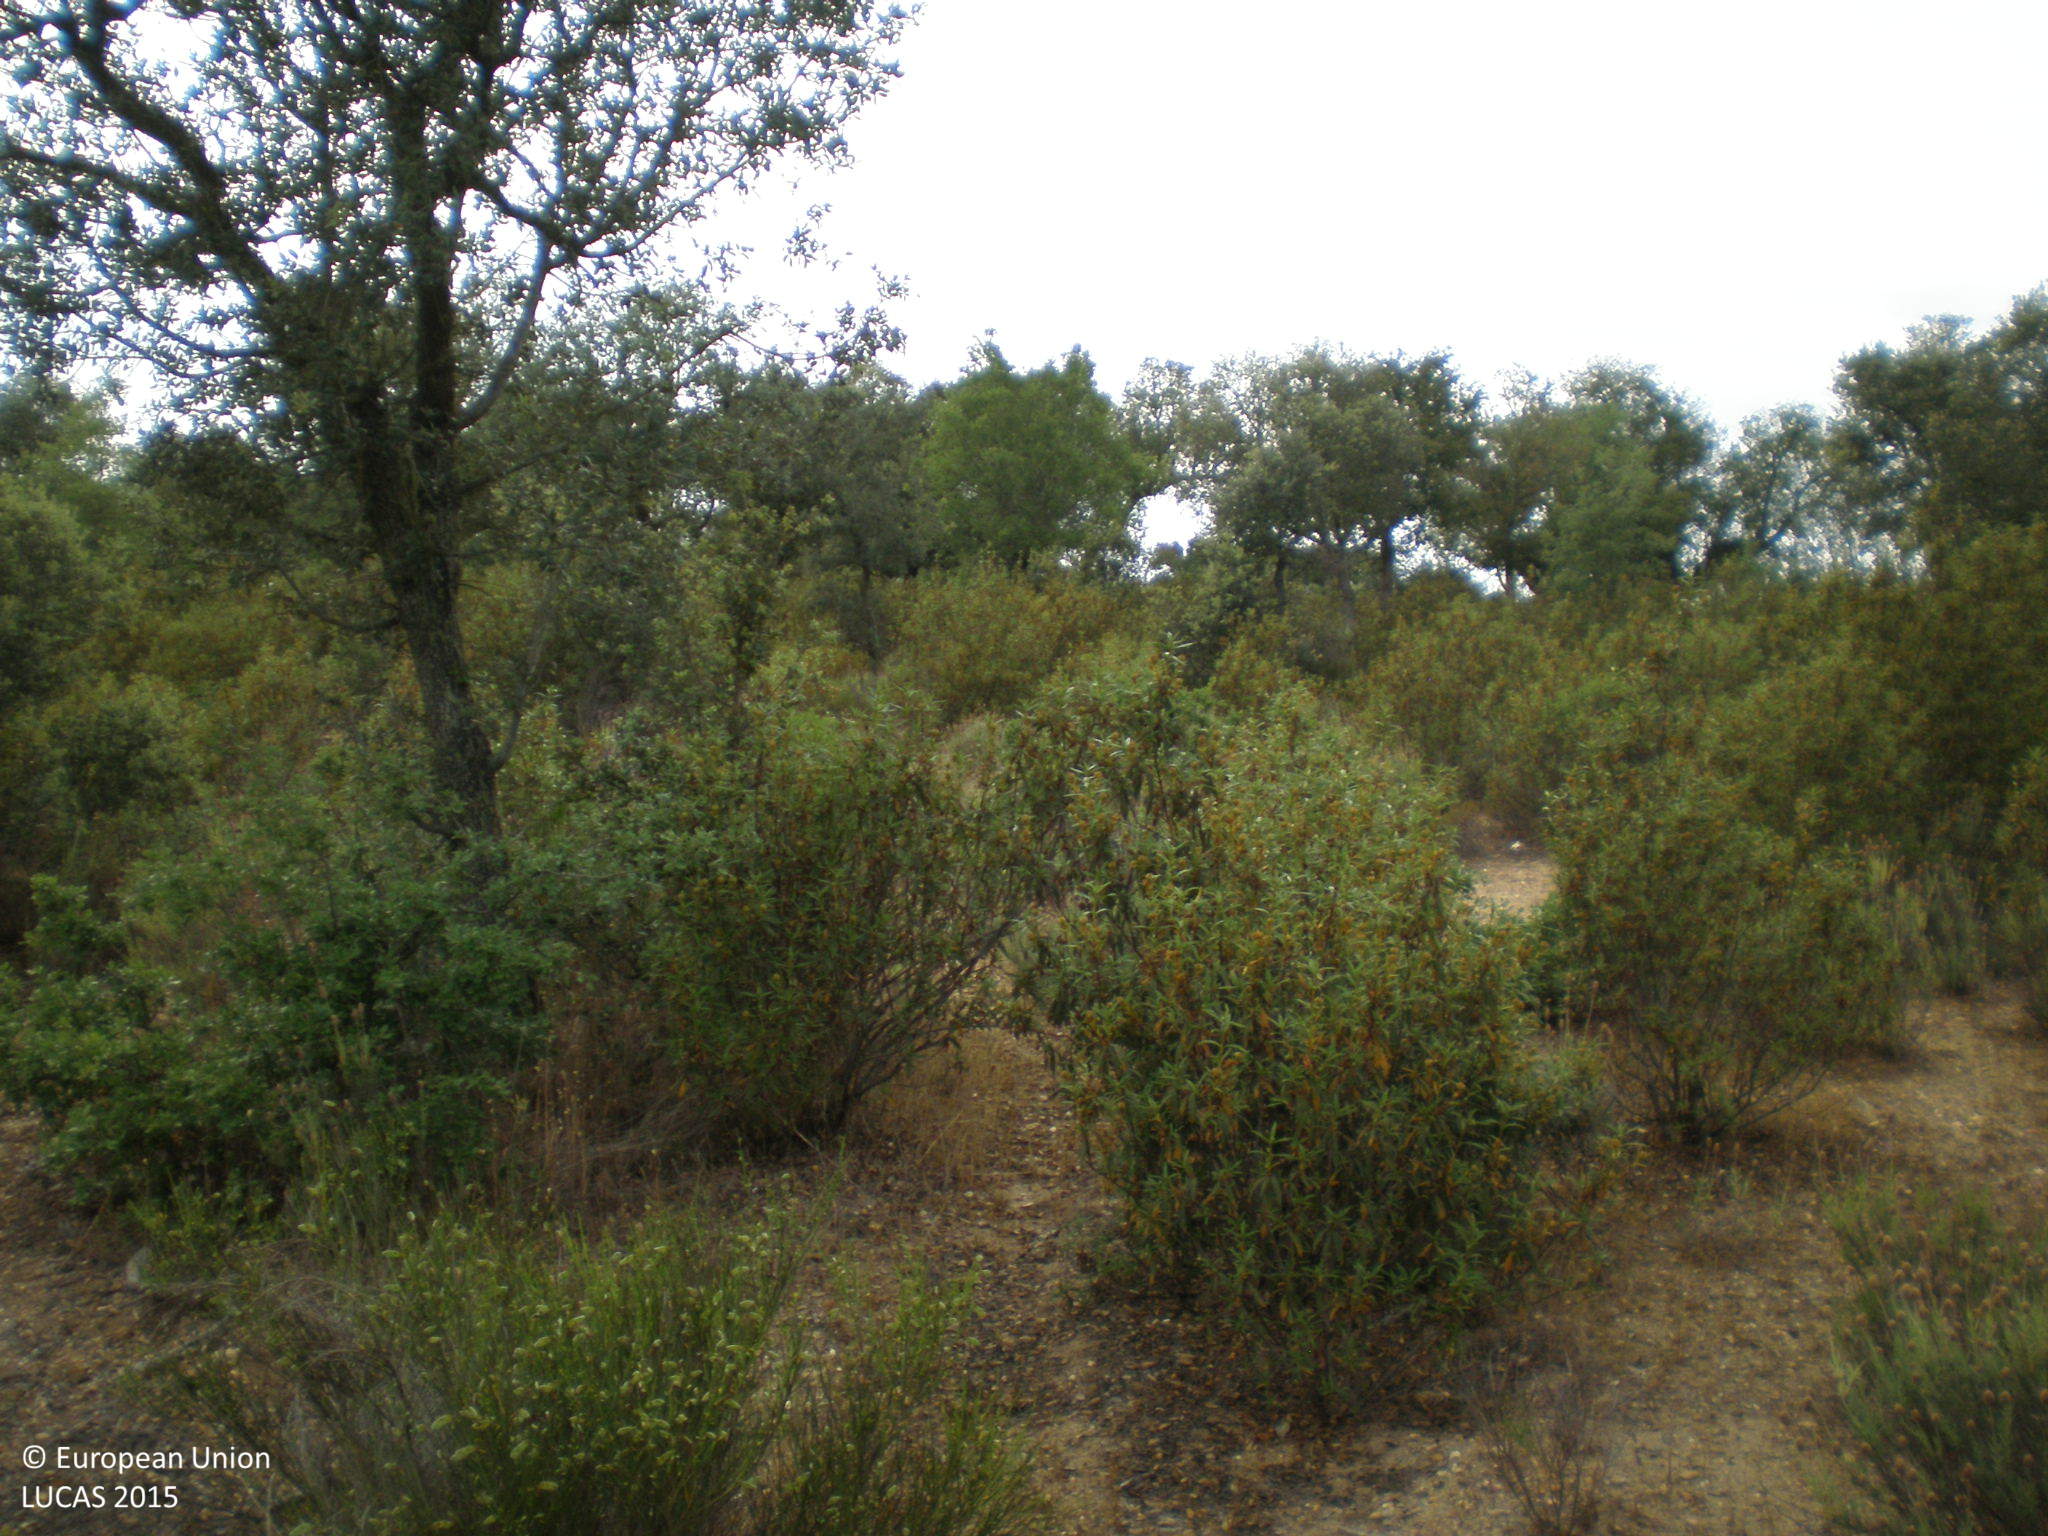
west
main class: Woodland
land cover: Broadleaved woodland
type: broadleaved evergreen forest
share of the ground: 25 - 50 %
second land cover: Grassland without tree/shrub cover
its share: 50 - 75 %
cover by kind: herbaceous plants 60 %, broadleaved forest trees 40 %
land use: Forestry
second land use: Agriculture (excluding fallow land and kitchen gardens)
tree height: < 5 m
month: June
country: ES
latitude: 41.1515
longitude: -5.7753
